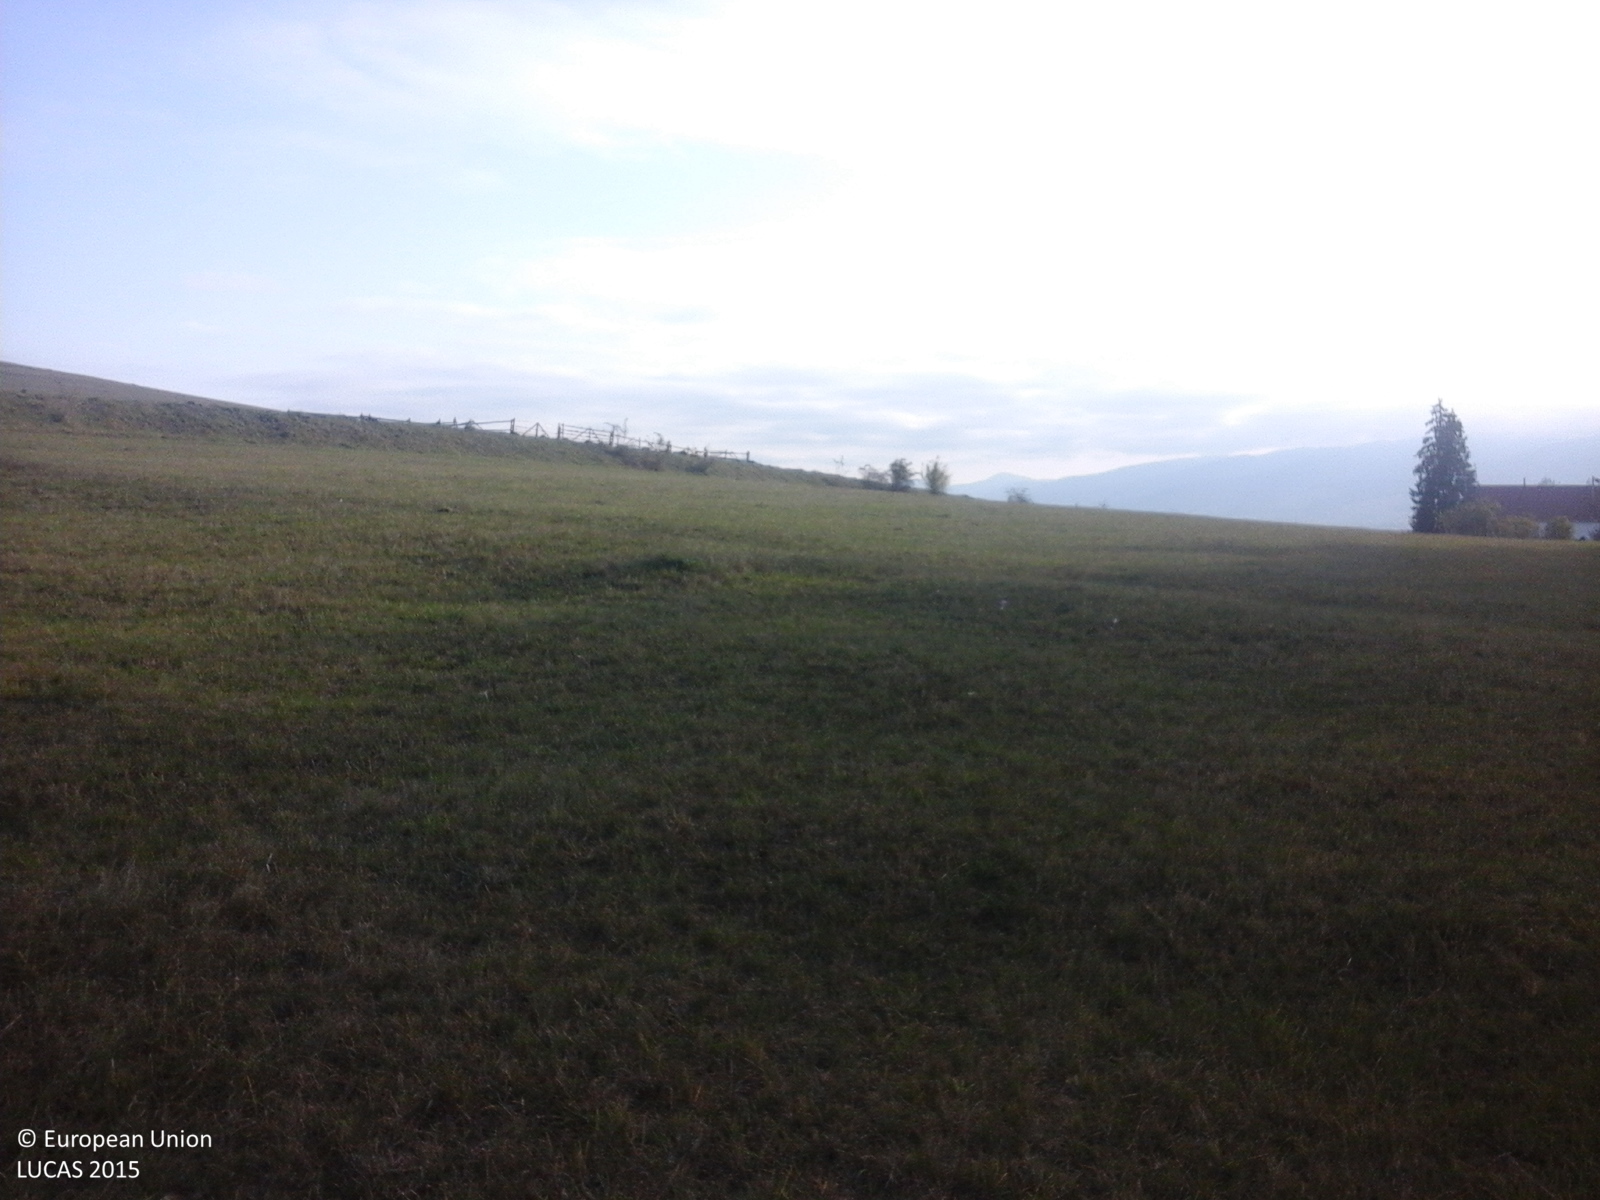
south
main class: Grassland
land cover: Grassland without tree/shrub cover
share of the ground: > 75 %
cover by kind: herbaceous plants 100 %
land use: Agriculture (excluding fallow land and kitchen gardens)
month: October
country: RO
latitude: 46.3516
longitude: 25.8531
